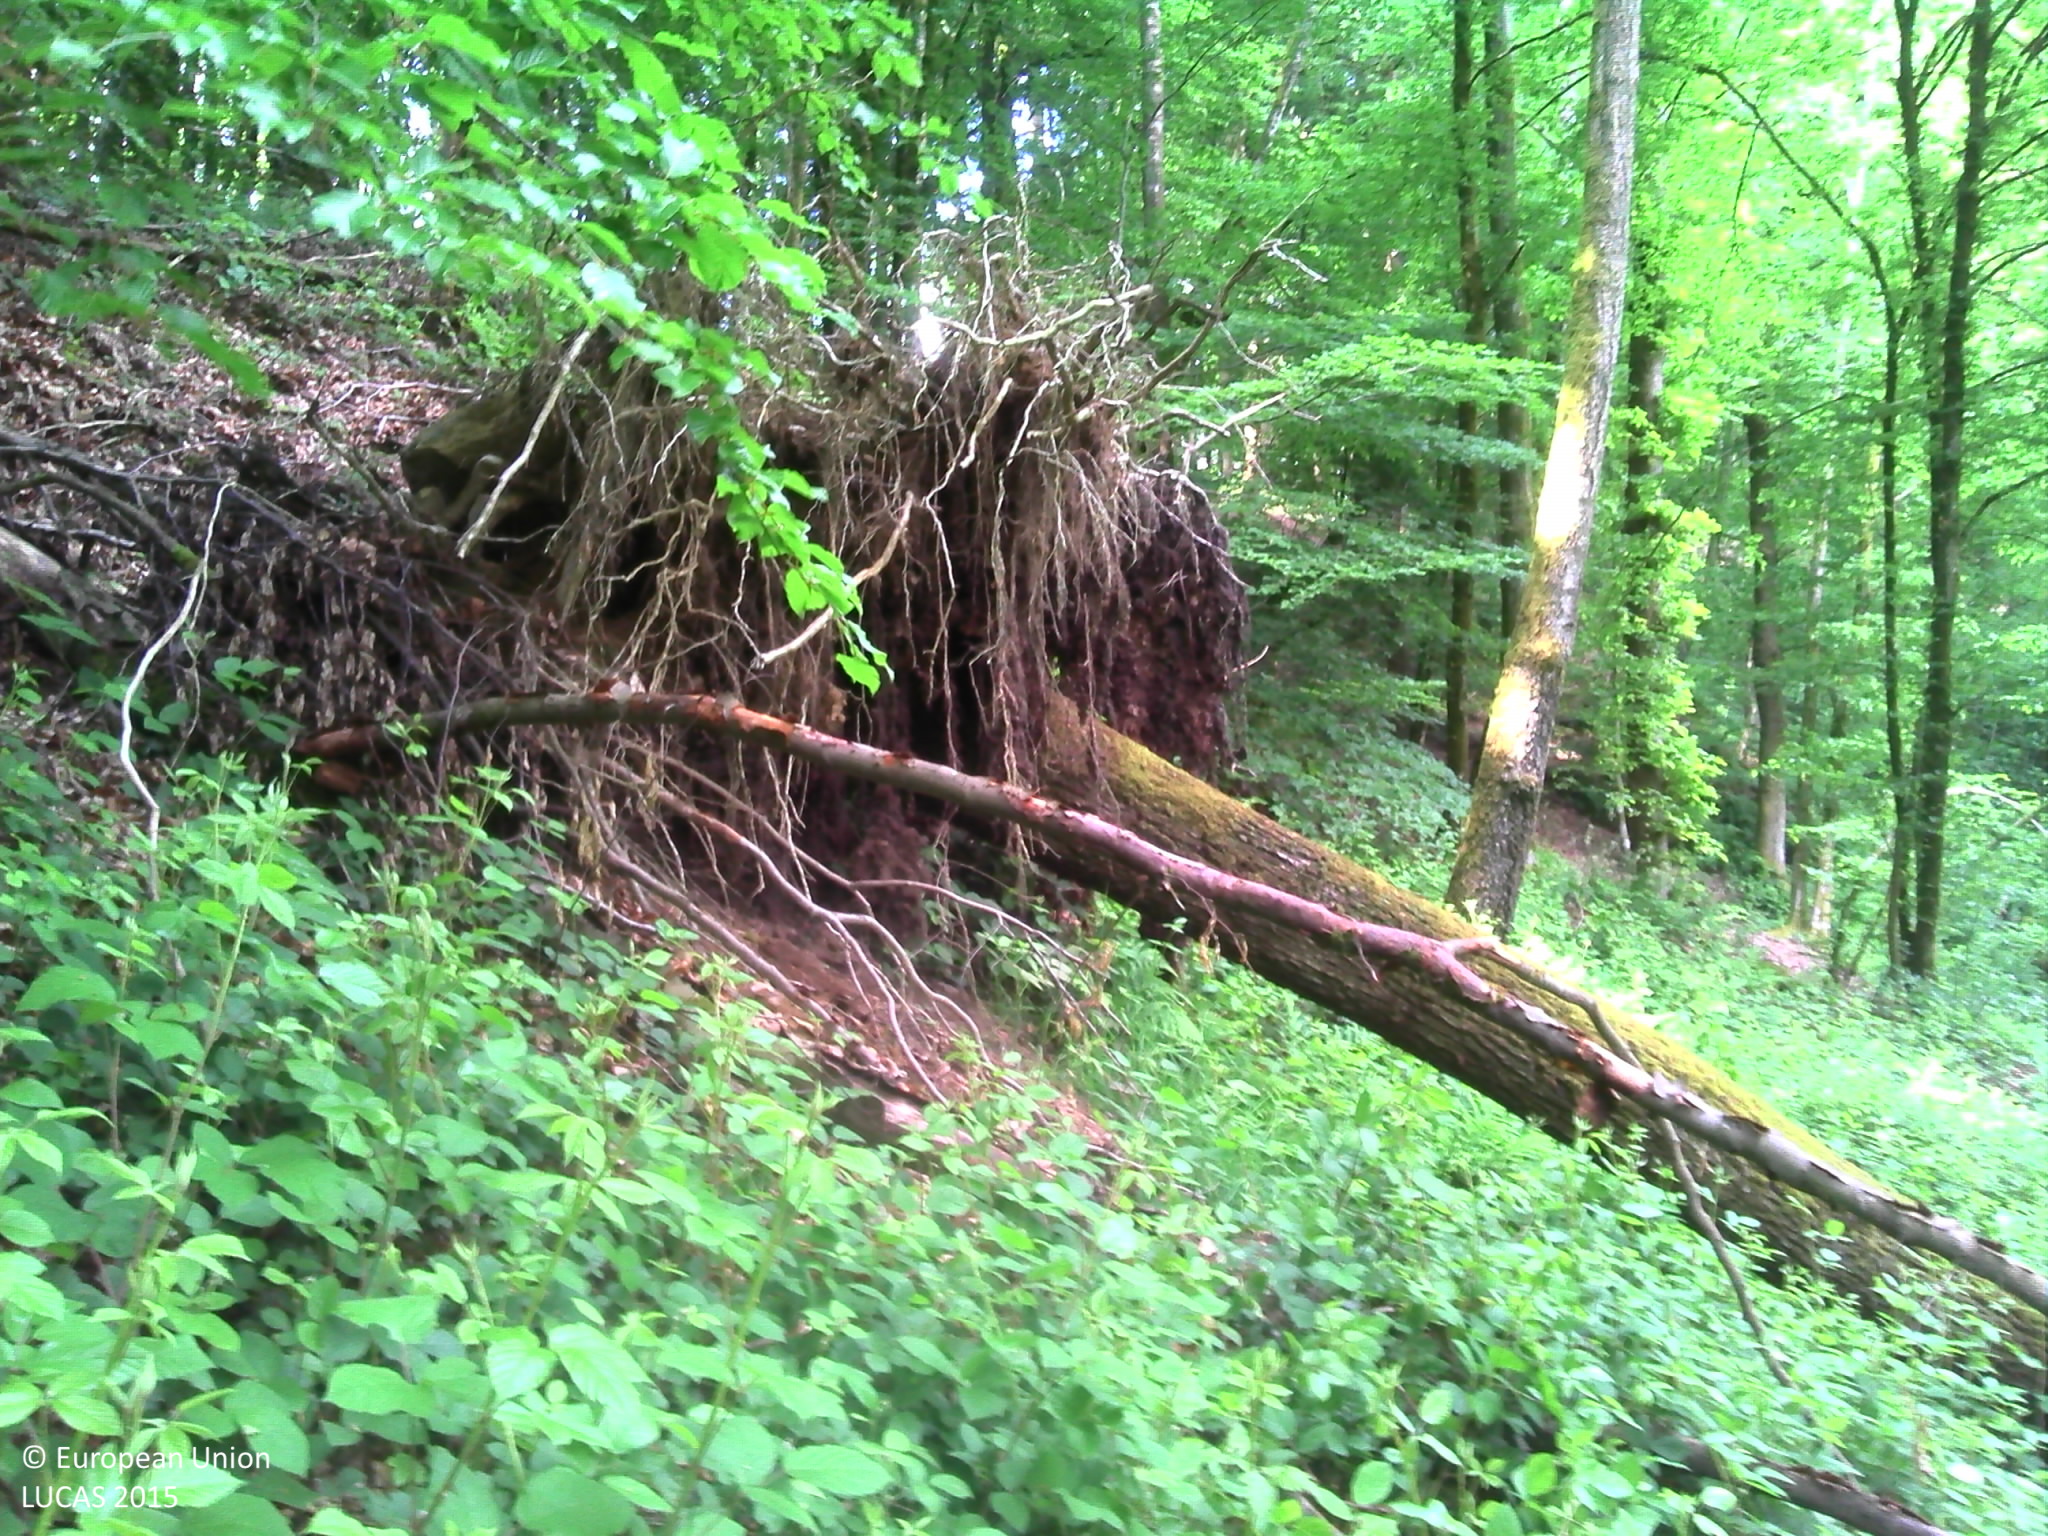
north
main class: Woodland
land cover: Broadleaved woodland
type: acidophilous oak and oak-birch forest
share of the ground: > 75 %
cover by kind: broadleaved forest trees 95 %, herbaceous plants 5 %
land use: Forestry
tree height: > 5 m
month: June
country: BE
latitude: 49.8895
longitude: 4.8888
